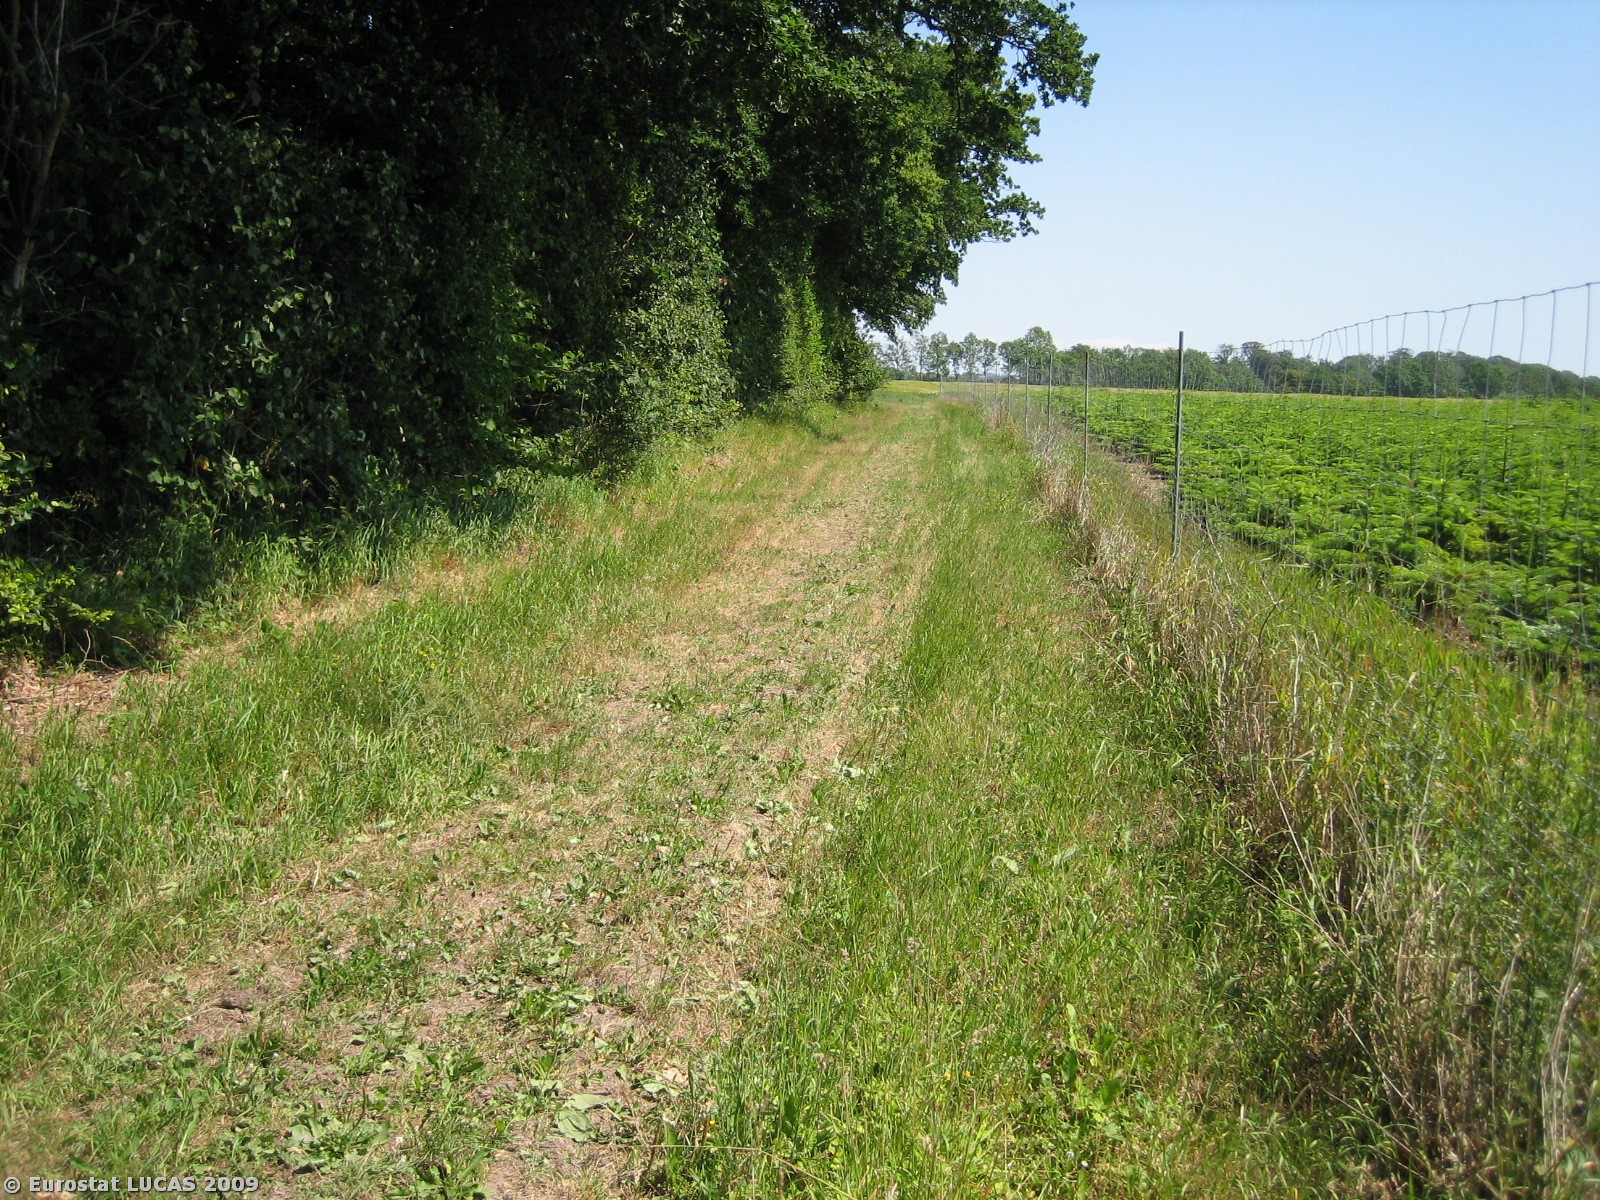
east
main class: Woodland
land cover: Coniferous woodland
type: hemiboreal forest and nemoral coniferous forest and mixed broadleaved-coniferous forest
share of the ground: 50 - 75 %
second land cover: Spontaneously vegetated surfaces
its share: 25 - 50 %
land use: Forestry
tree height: > 5 m
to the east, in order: Coniferous woodland; Spontaneously vegetated surfaces; Fences; Grass margins; Tracks; Broadleaved woodland; Tracks; Grass margins; Barley
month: July
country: DK
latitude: 55.3589
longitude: 9.2908
